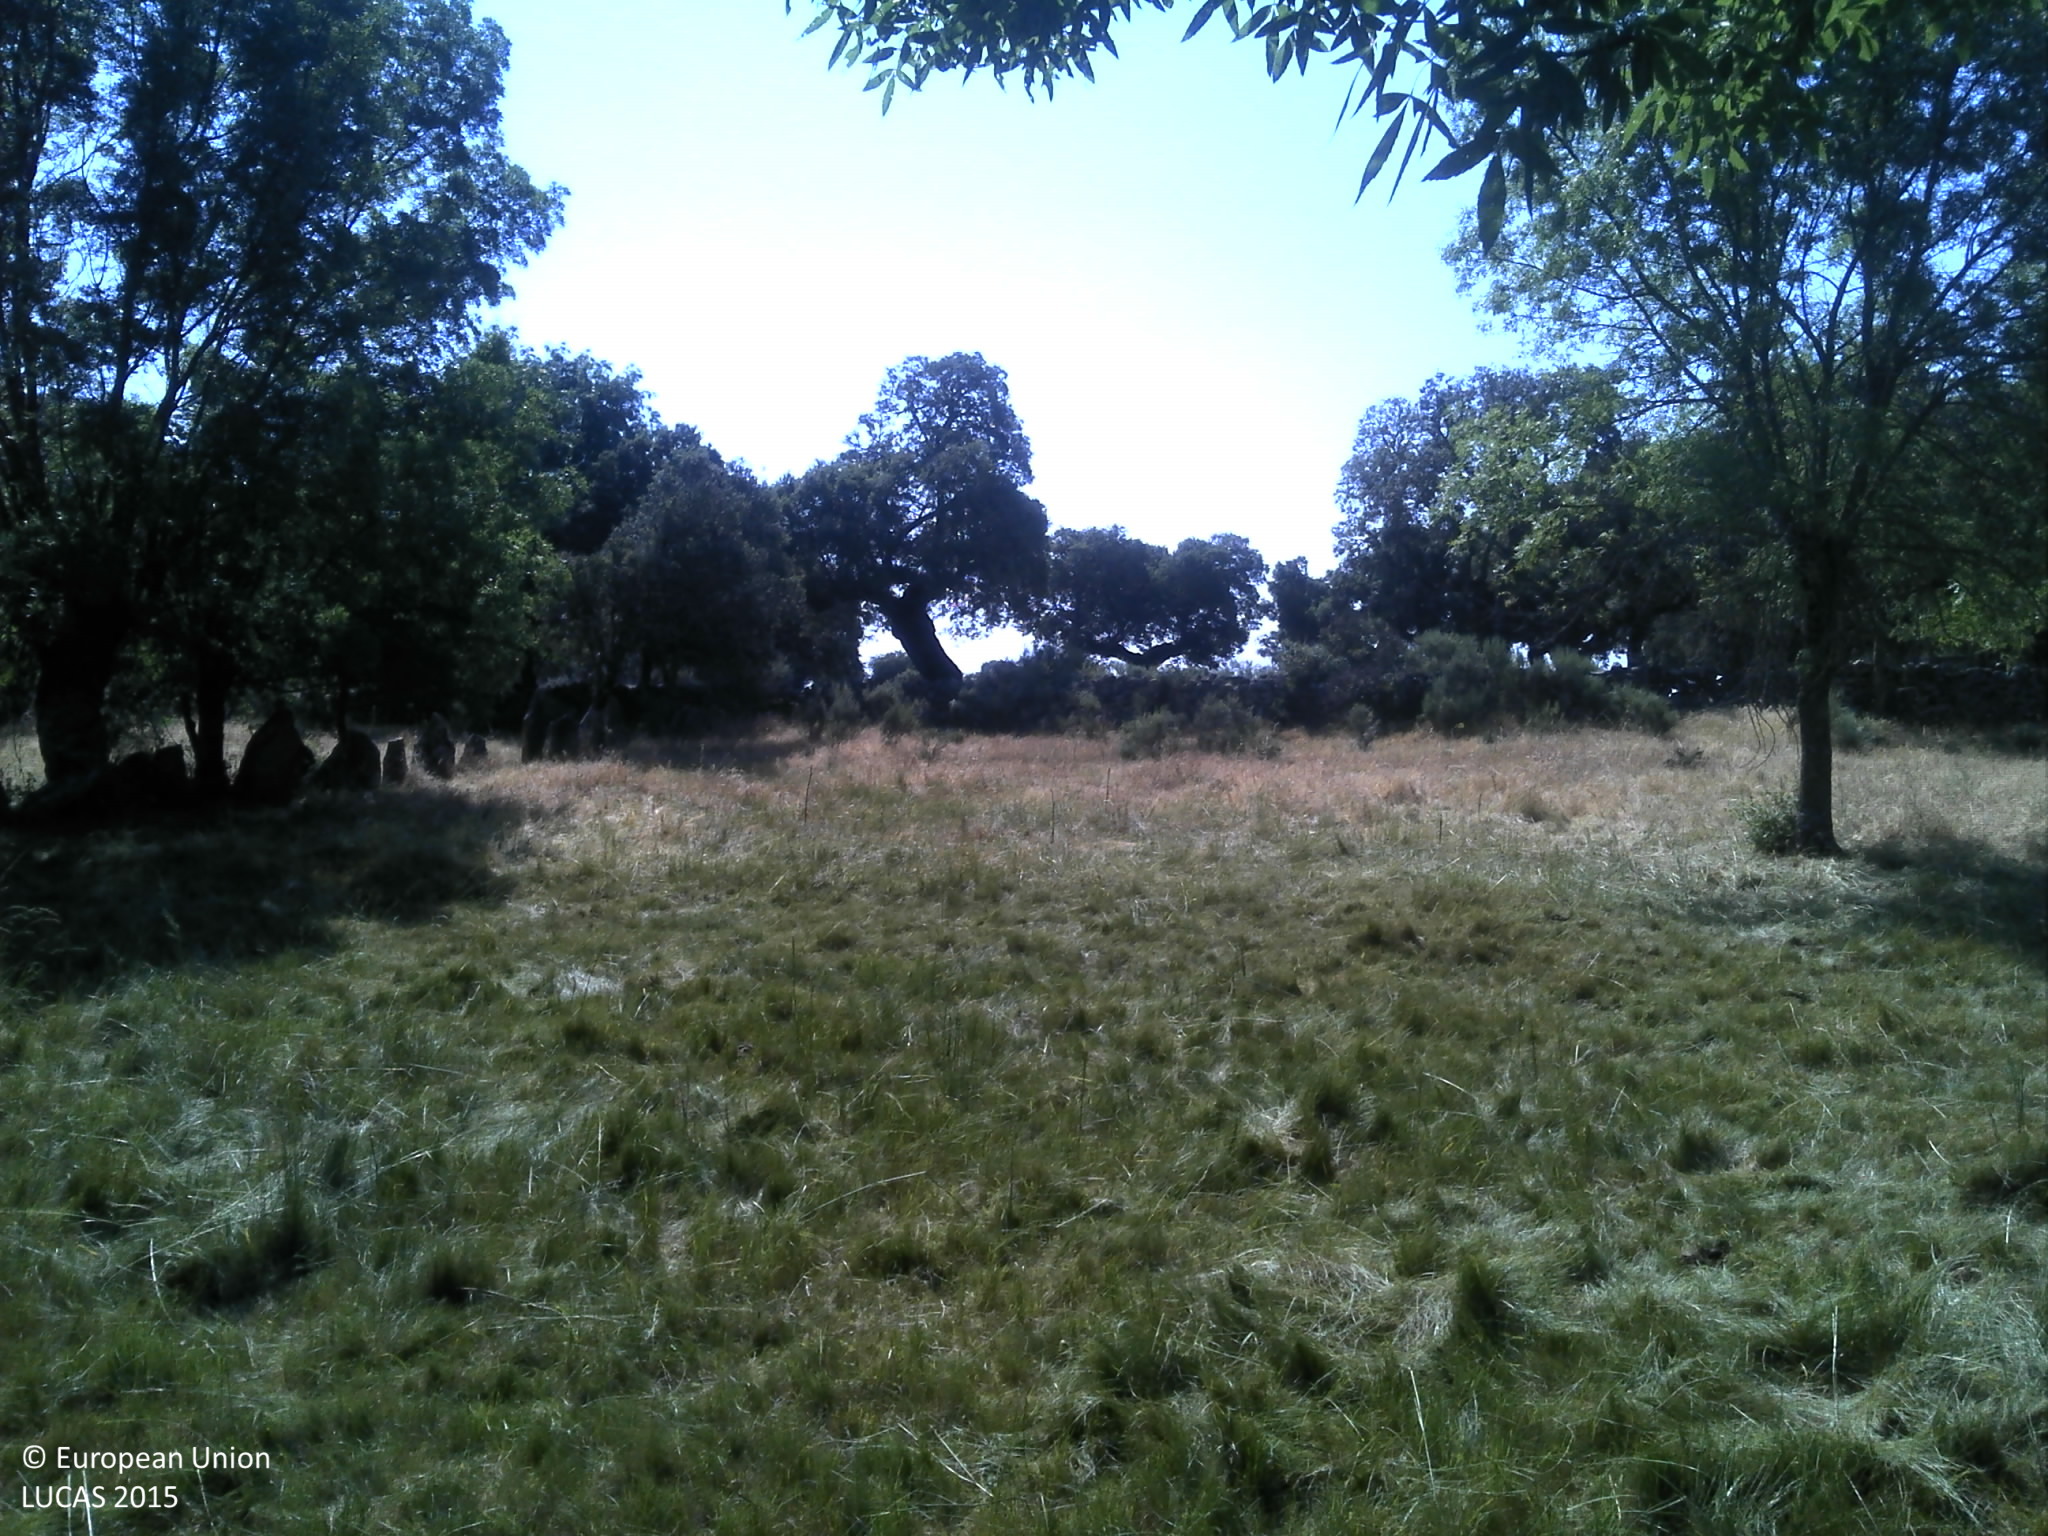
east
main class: Grassland
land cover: Grassland with sparse tree/shrub cover
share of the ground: 50 - 75 %
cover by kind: herbaceous plants 85 %, broadleaved forest trees 5 %, unconsolidated bare surface 5 %
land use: Agriculture (excluding fallow land and kitchen gardens)
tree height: > 5 m
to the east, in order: Grassland with sparse tree/shrub cover; Abandoned hedges; Dry stone walls; Grassland with sparse tree/shrub cover; Dry stone walls; Fences; Tracks; Fences; Spontaneously vegetated surfaces; Dry stone walls; Fences; Spontaneously vegetated surfaces; Dry stone walls; Fences; Spontaneously vegetated surfaces; Broadleaved woodland; Tracks; Spontaneously vegetated surfaces
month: June
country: PT
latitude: 40.5526
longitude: -6.8291
